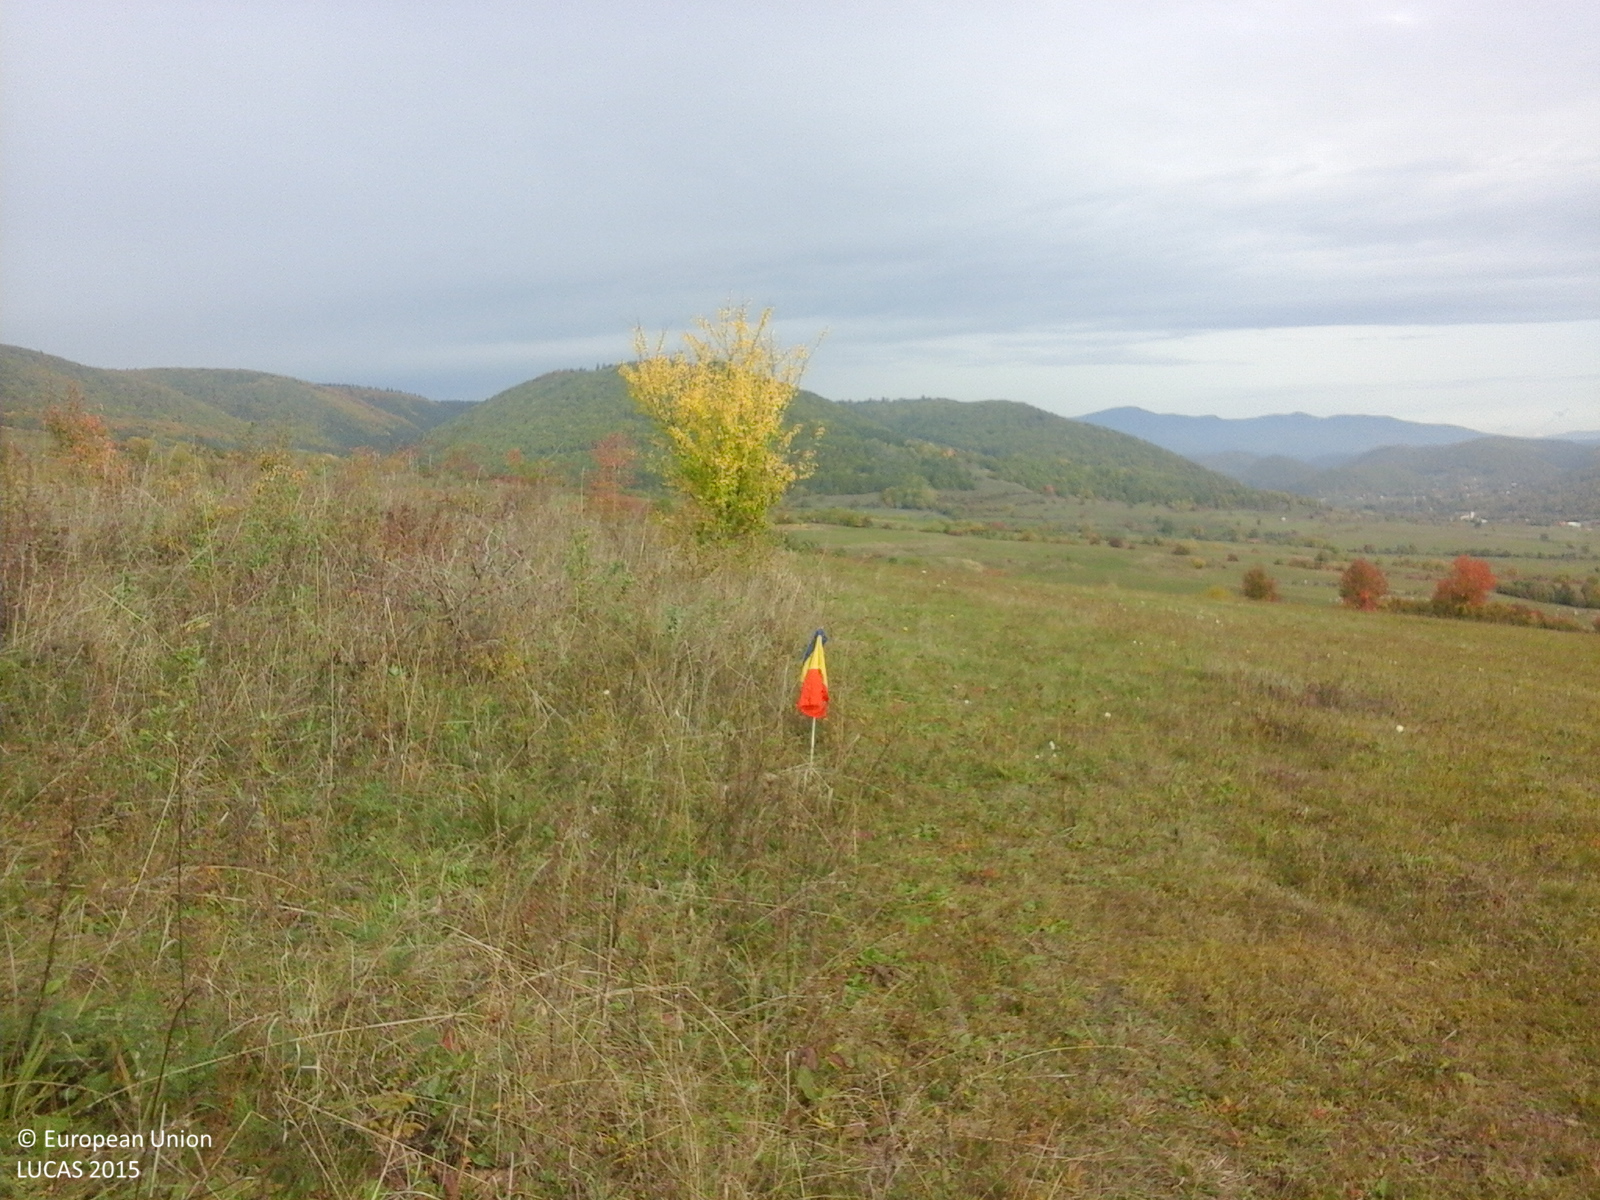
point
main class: Grassland
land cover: Grassland without tree/shrub cover
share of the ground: > 75 %
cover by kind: herbaceous plants 100 %
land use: Agriculture (excluding fallow land and kitchen gardens)
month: October
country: RO
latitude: 46.4056
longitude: 25.3630
